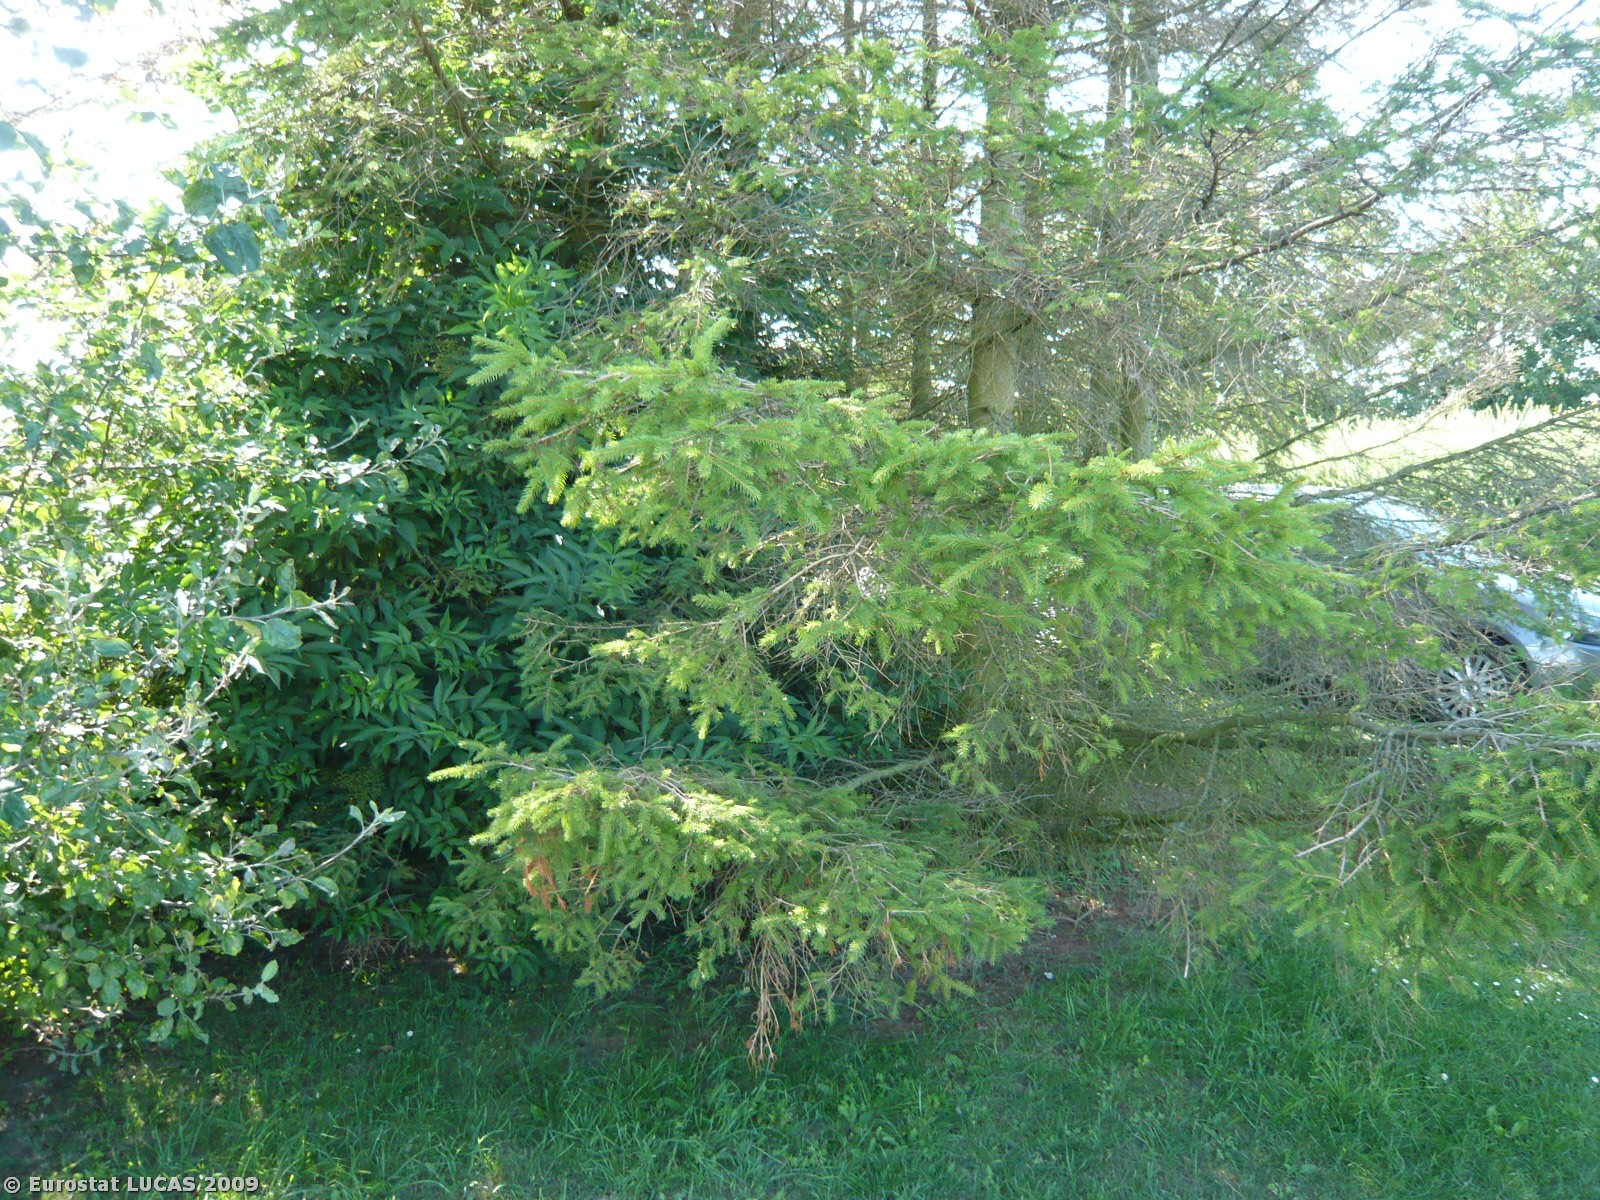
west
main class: Grassland
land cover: Grassland without tree/shrub cover
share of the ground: > 75 %
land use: Residential
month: July
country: DK
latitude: 55.7462
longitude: 11.6074
